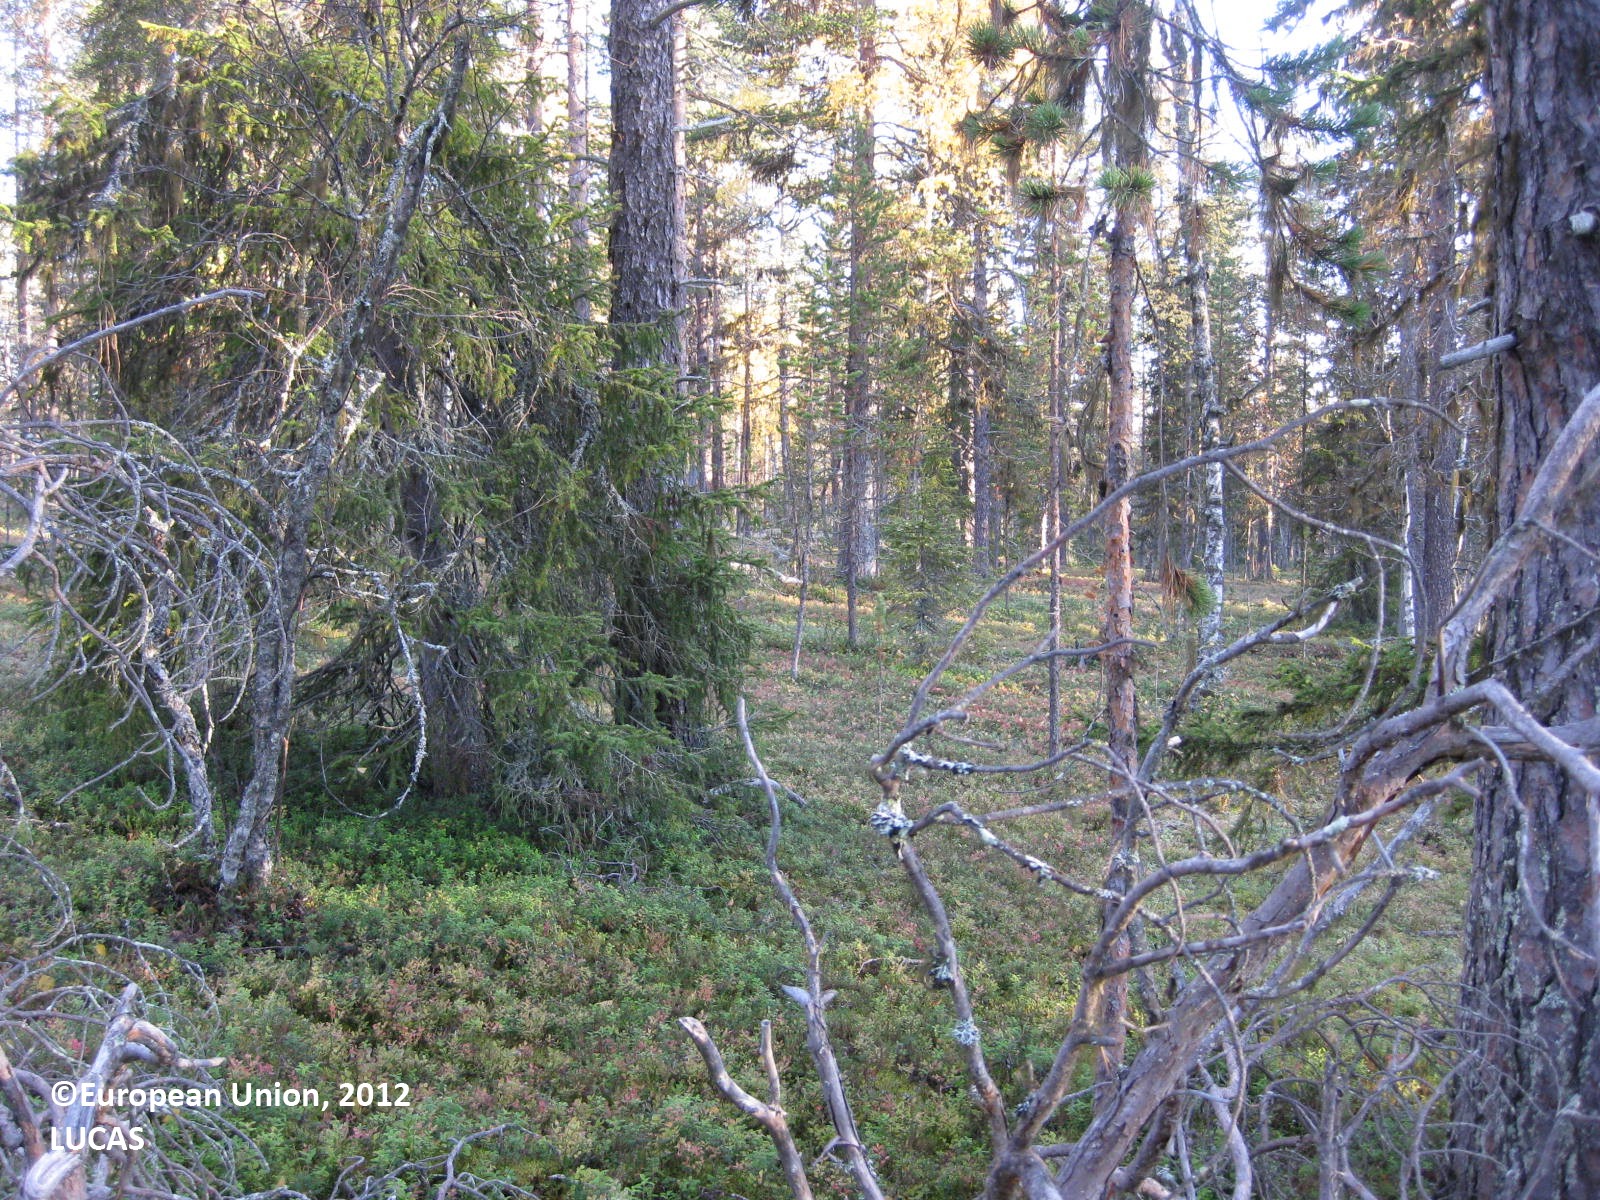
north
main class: Woodland
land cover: Other coniferous woodland
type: boreal forest
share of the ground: > 75 %
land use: Semi-natural and natural areas not in use
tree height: > 5 m
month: September
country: FI
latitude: 67.9583
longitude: 24.0332
